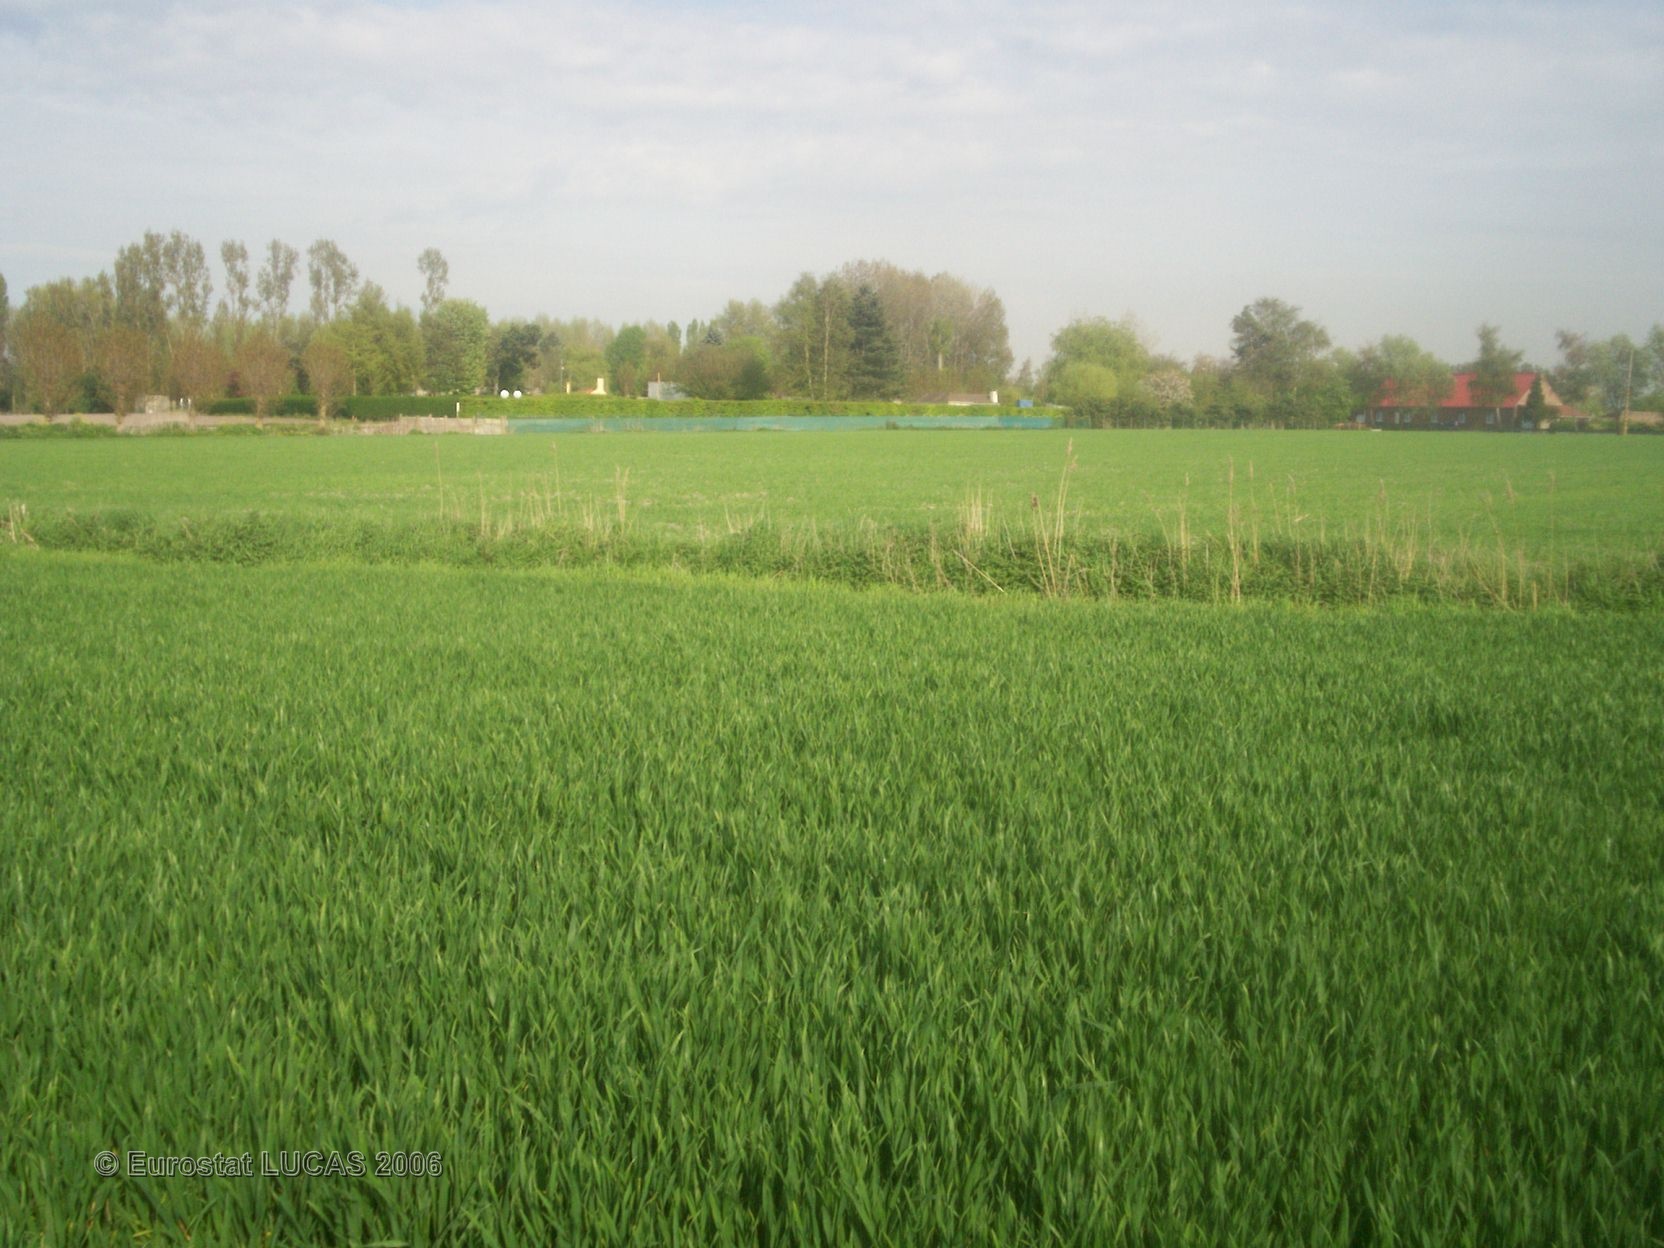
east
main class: Cropland
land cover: Common wheat
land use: Agriculture (excluding fallow land and kitchen gardens)
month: May
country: FR
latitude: 50.9813
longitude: 2.4519
